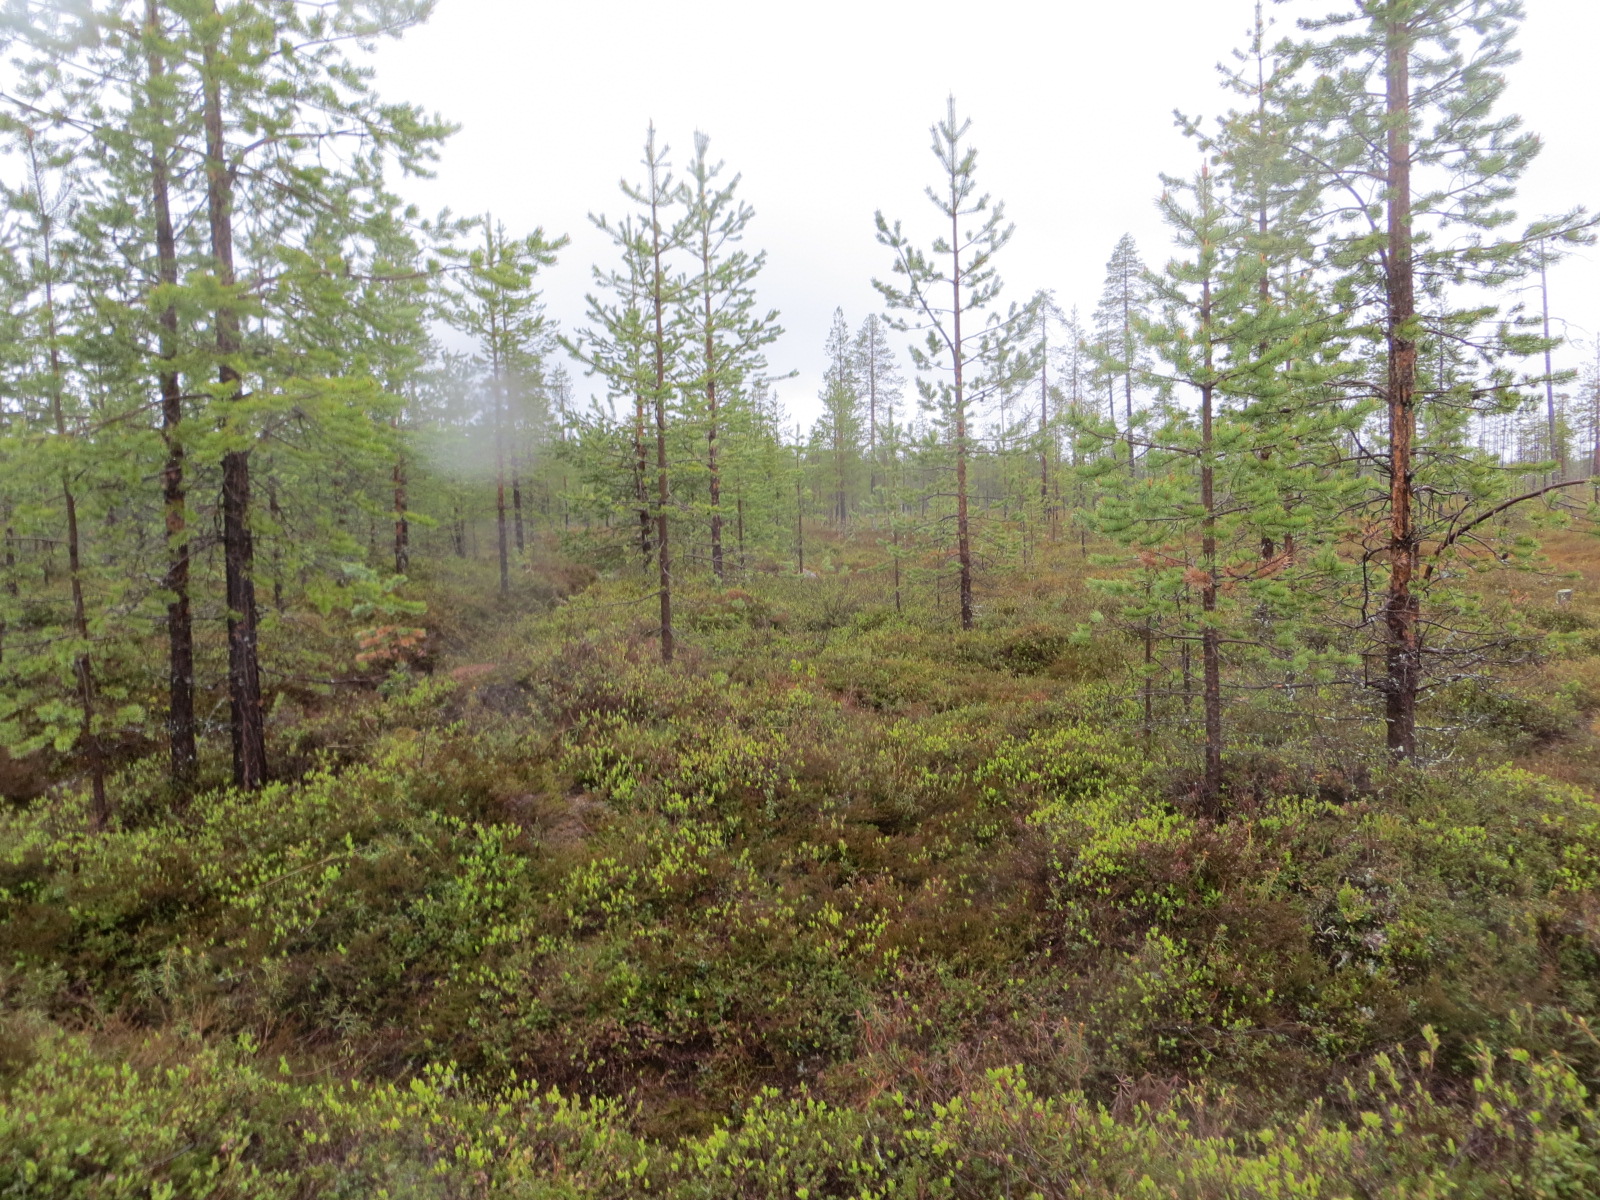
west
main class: Woodland
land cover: Pine dominated coniferous woodland
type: mire and swamp forests
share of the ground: 25 - 50 %
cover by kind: shrubs 60 %, coniferous forest trees 40 %
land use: Forestry
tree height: > 5 m
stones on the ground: < 10 %
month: June
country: FI
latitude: 66.9777
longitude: 25.9457
